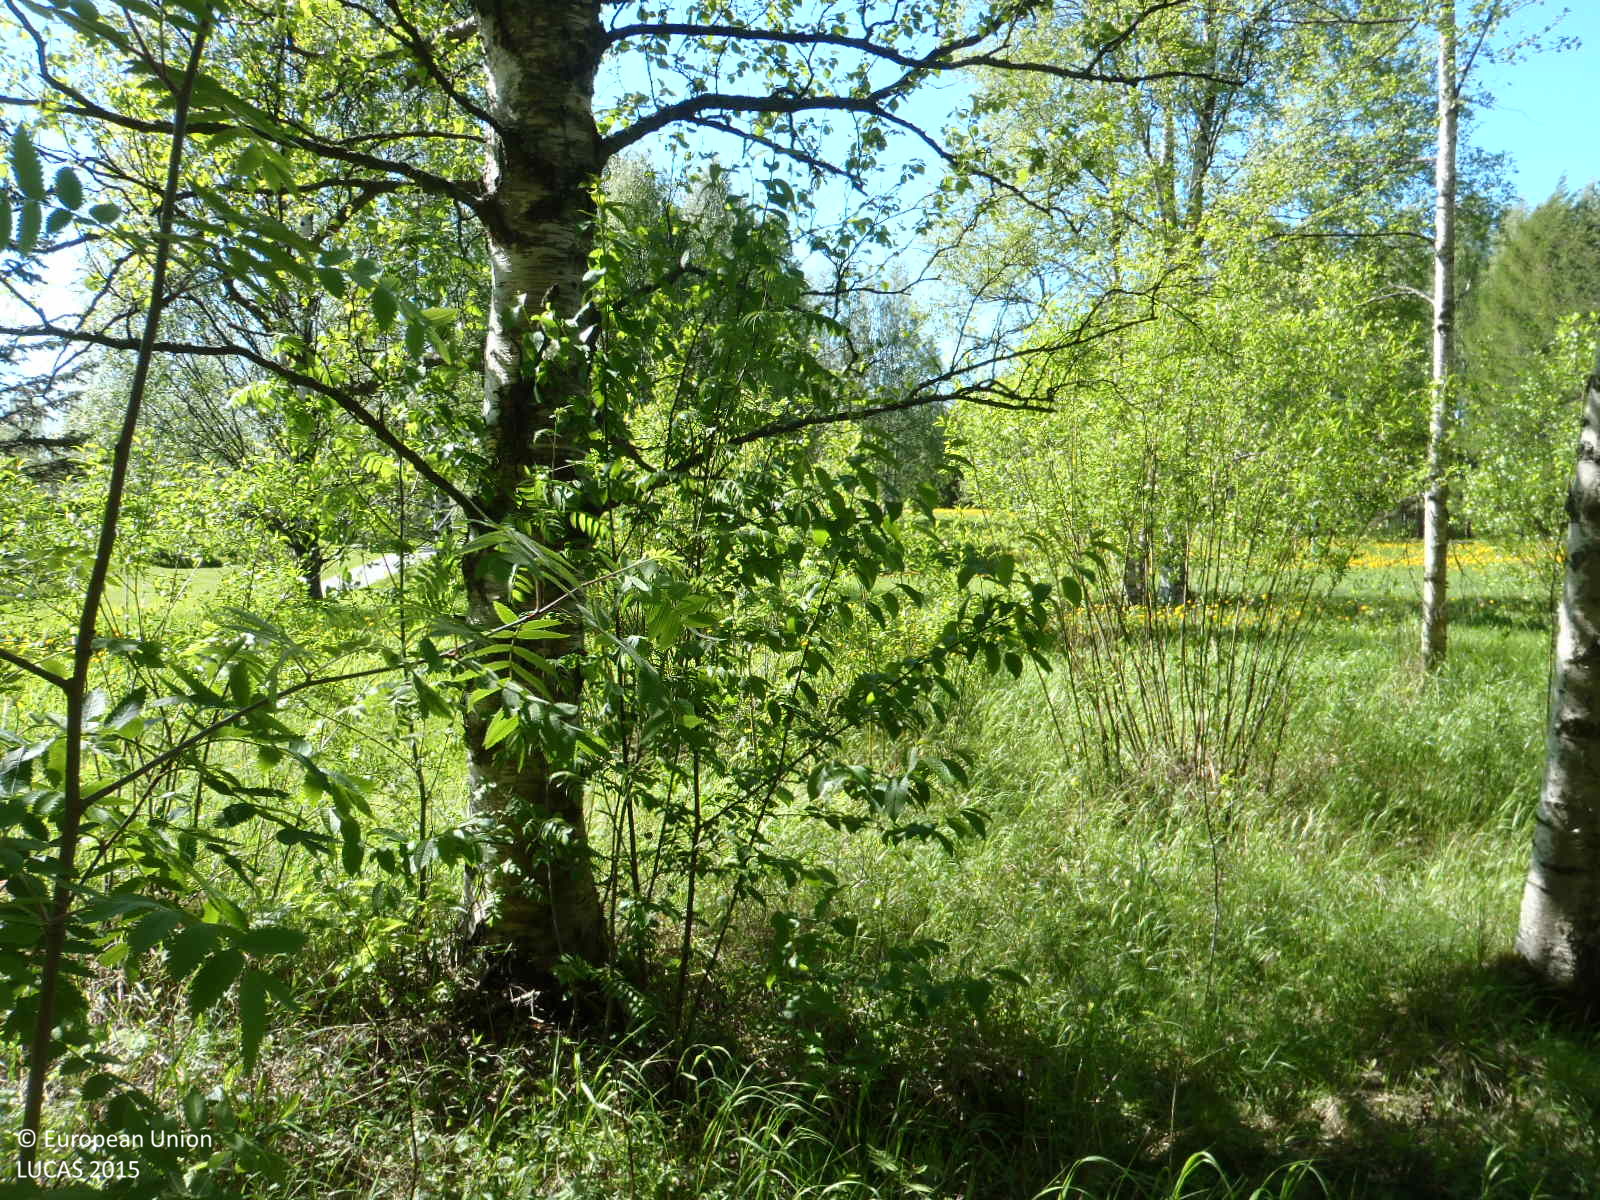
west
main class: Woodland
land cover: Other mixed woodland
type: boreal forest
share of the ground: 50 - 75 %
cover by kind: broadleaved forest trees 40 %, herbaceous plants 30 %, coniferous forest trees 20 %, shrubs 10 %
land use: Amenities, museums, leisure
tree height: > 5 m
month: June
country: FI
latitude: 64.9983
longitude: 25.5001
